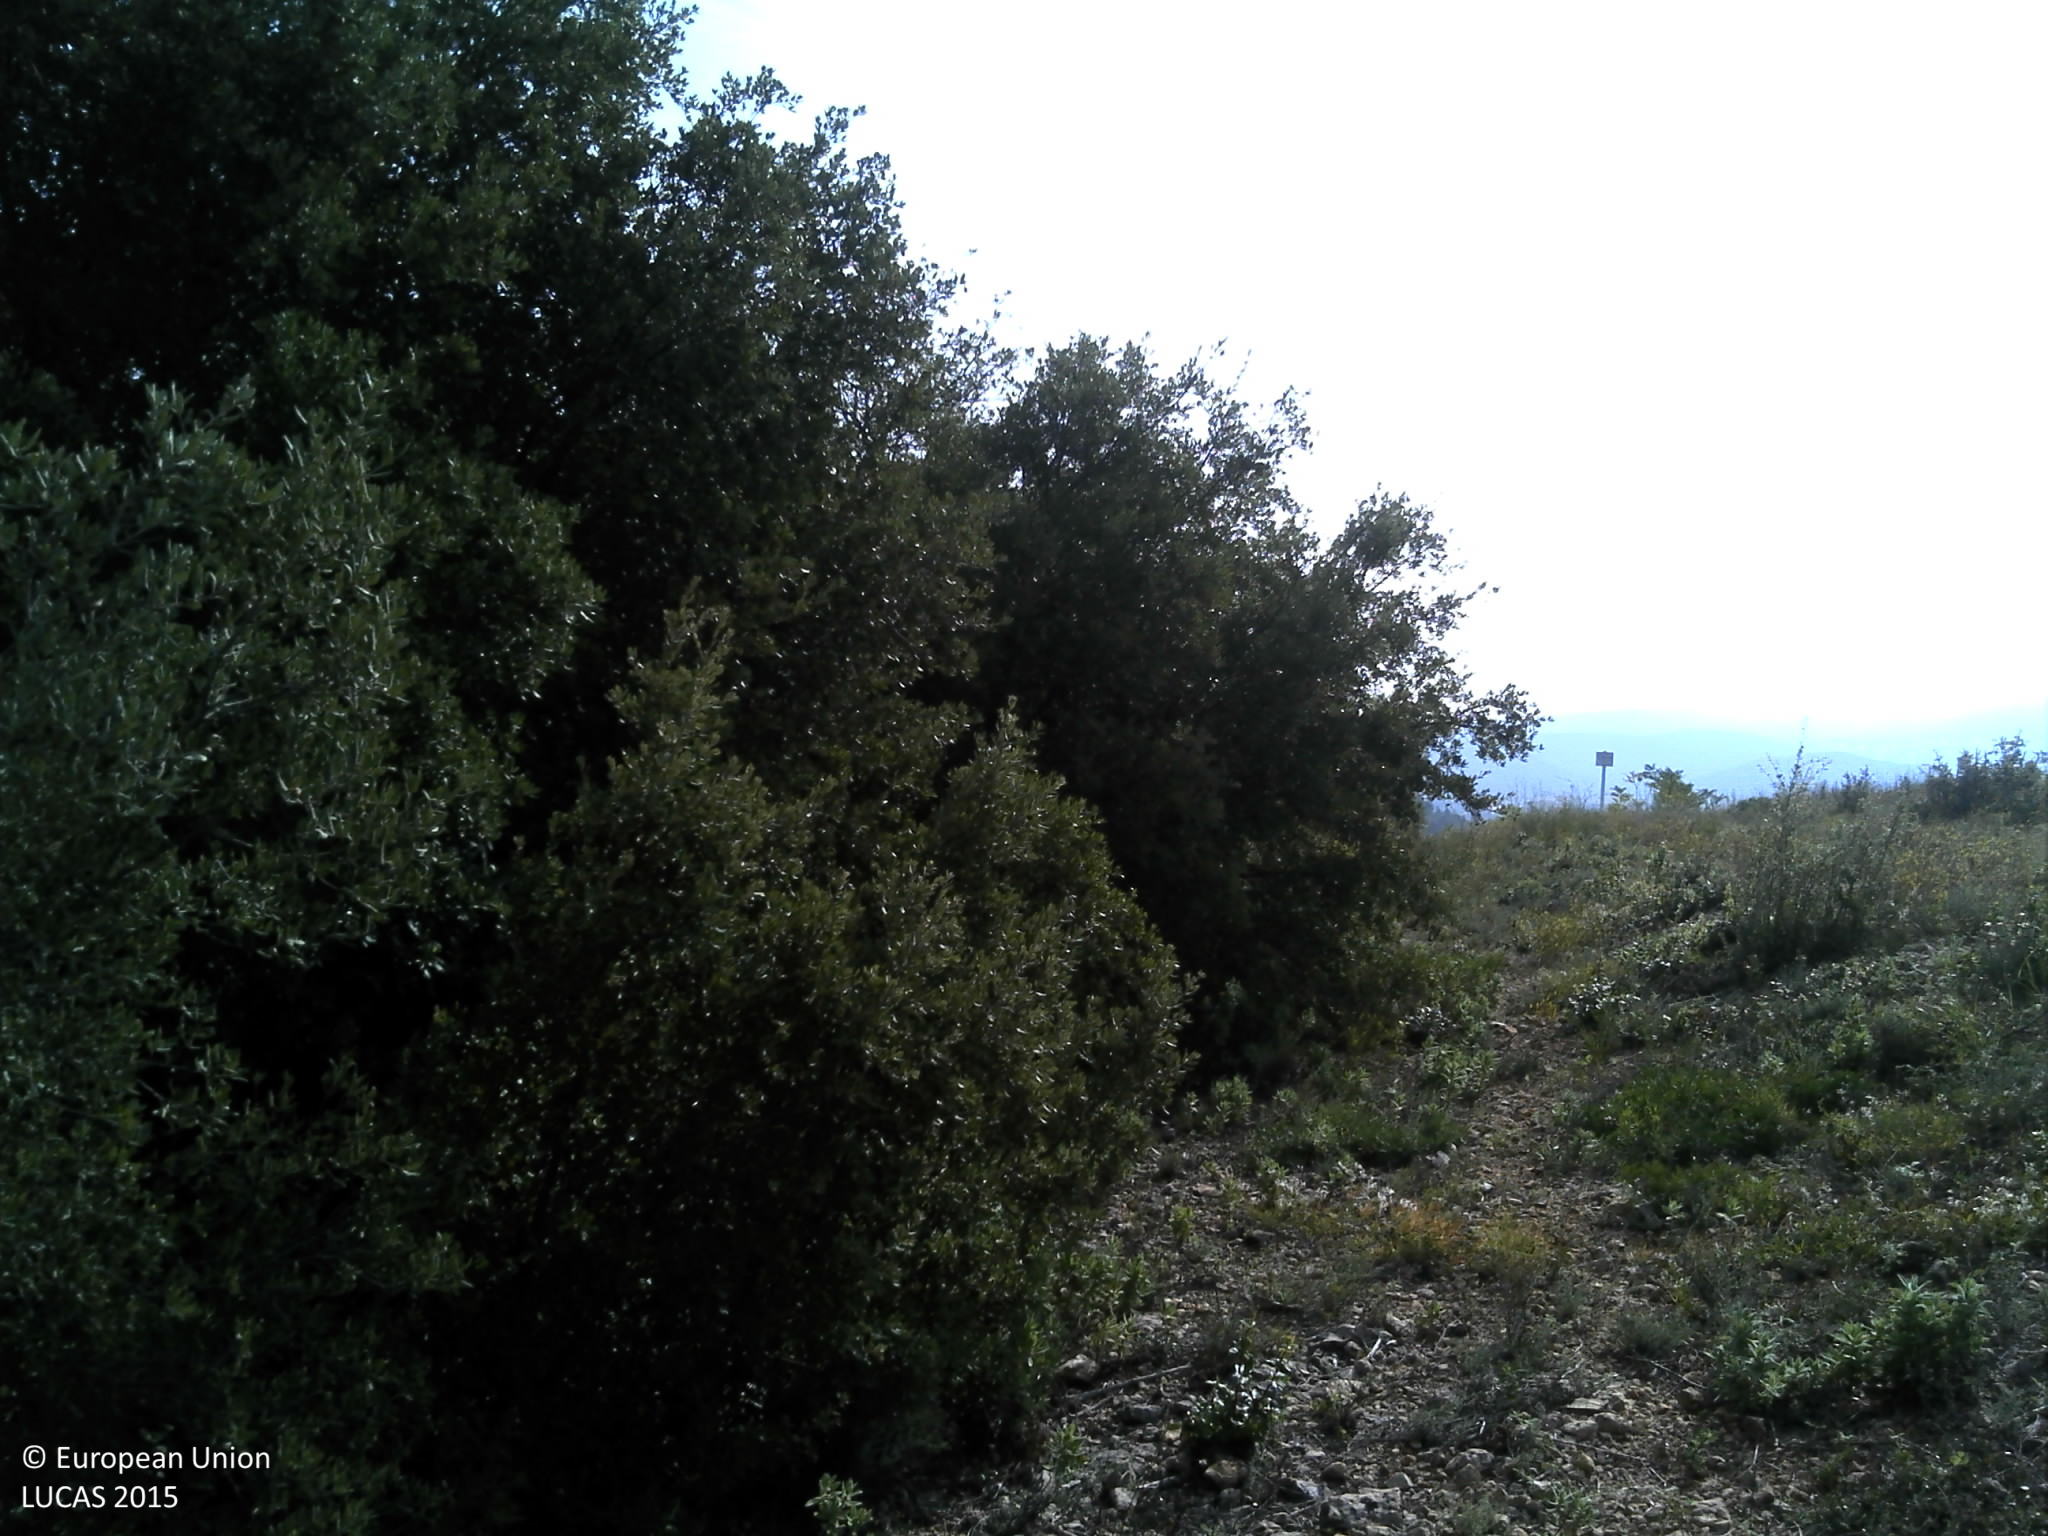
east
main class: Woodland
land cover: Broadleaved woodland
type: broadleaved evergreen forest
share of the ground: > 75 %
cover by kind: broadleaved forest trees 80 %, shrubs 10 %, unconsolidated bare surface 10 %
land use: Semi-natural and natural areas not in use
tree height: < 5 m
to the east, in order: Broadleaved woodland; Tracks; Broadleaved woodland; Tracks; Pine dominated mixed woodland
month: October
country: FR
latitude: 43.4793
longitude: 6.5097
